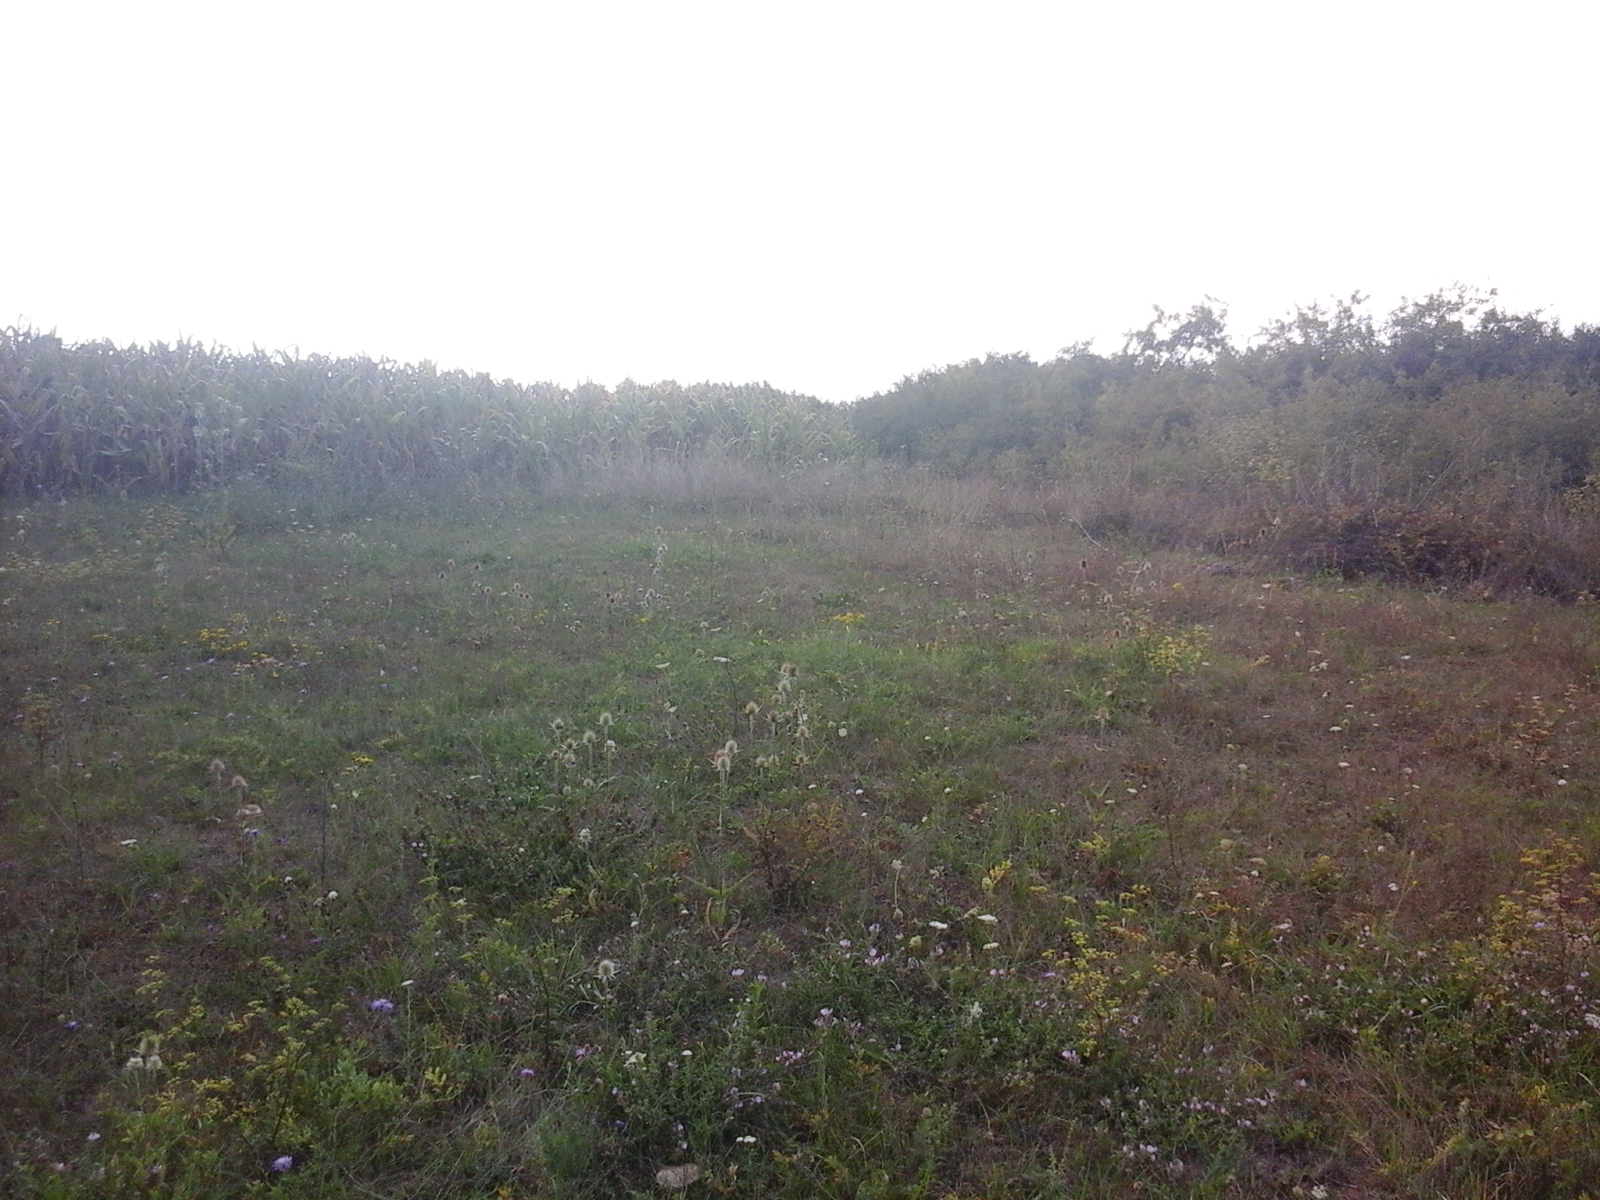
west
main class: Grassland
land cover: Grassland without tree/shrub cover
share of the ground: > 75 %
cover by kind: herbaceous plants 100 %
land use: Agriculture (excluding fallow land and kitchen gardens)
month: August
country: RO
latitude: 46.7366
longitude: 21.5961
